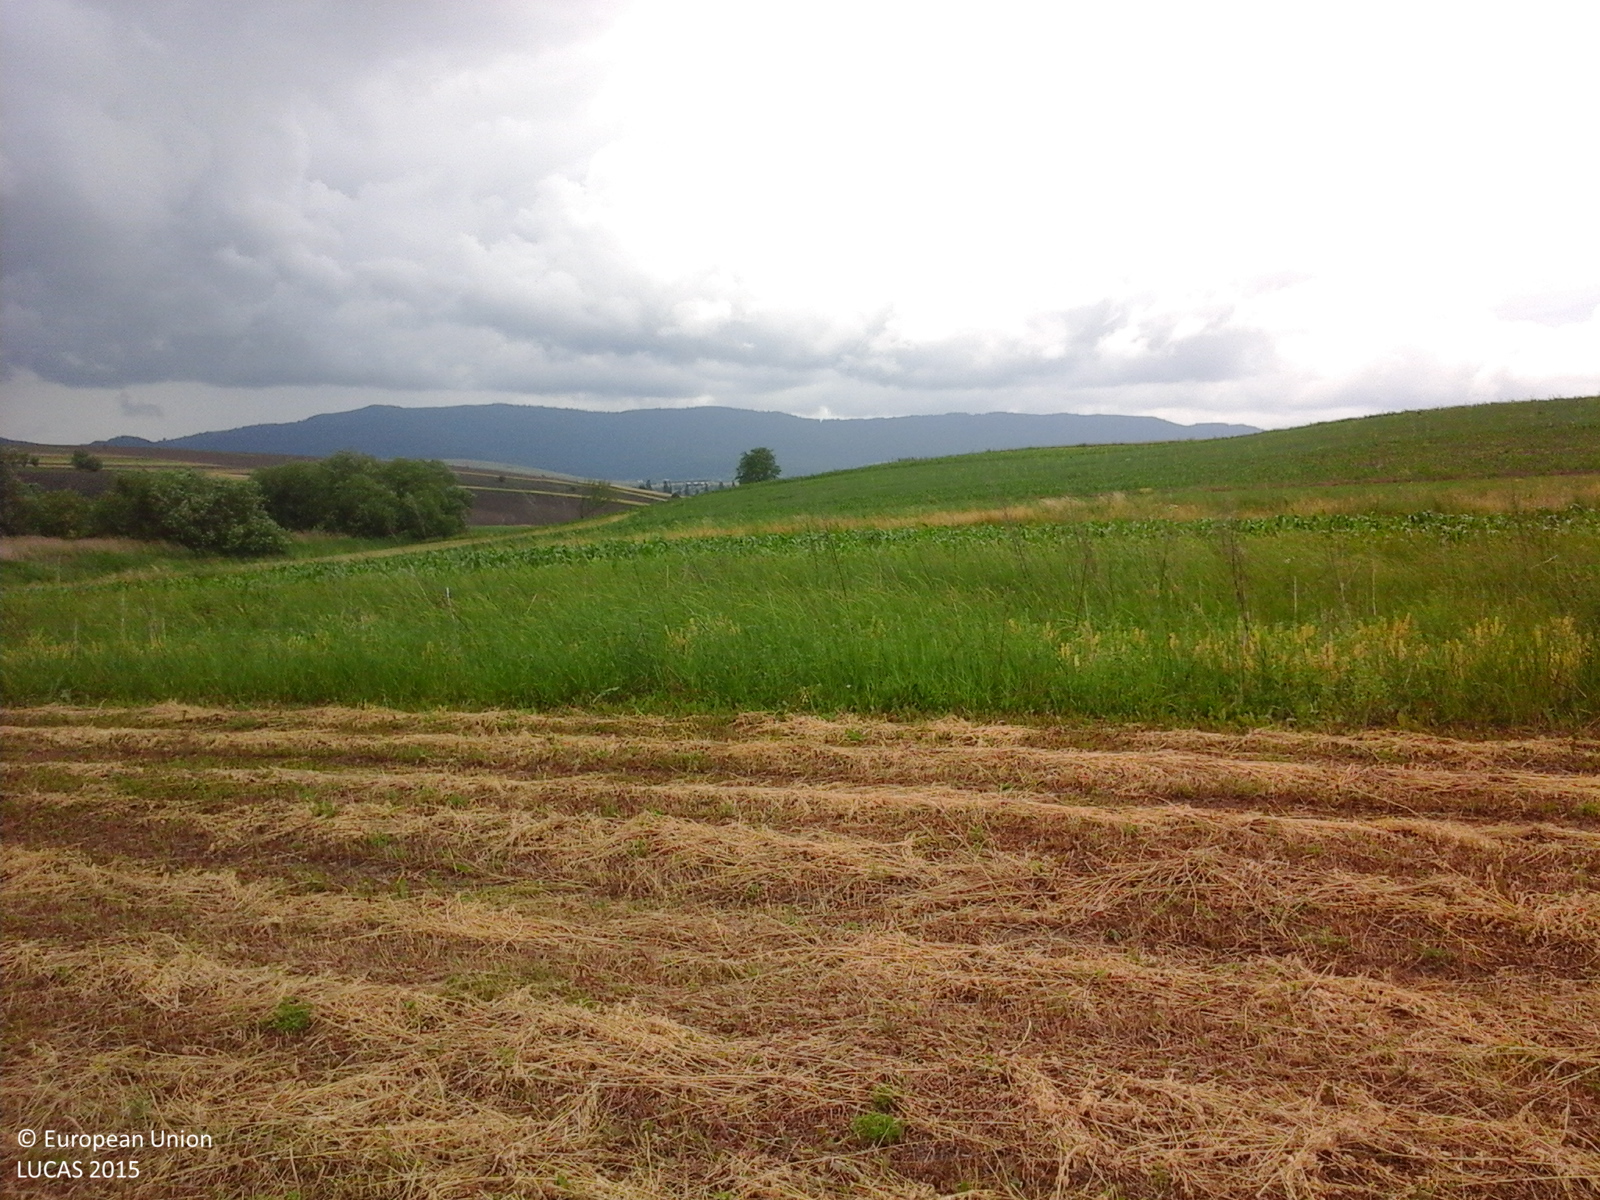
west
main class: Cropland
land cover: Soya
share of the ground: > 75 %
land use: Agriculture (excluding fallow land and kitchen gardens)
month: May
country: RO
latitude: 47.1402
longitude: 26.3400
